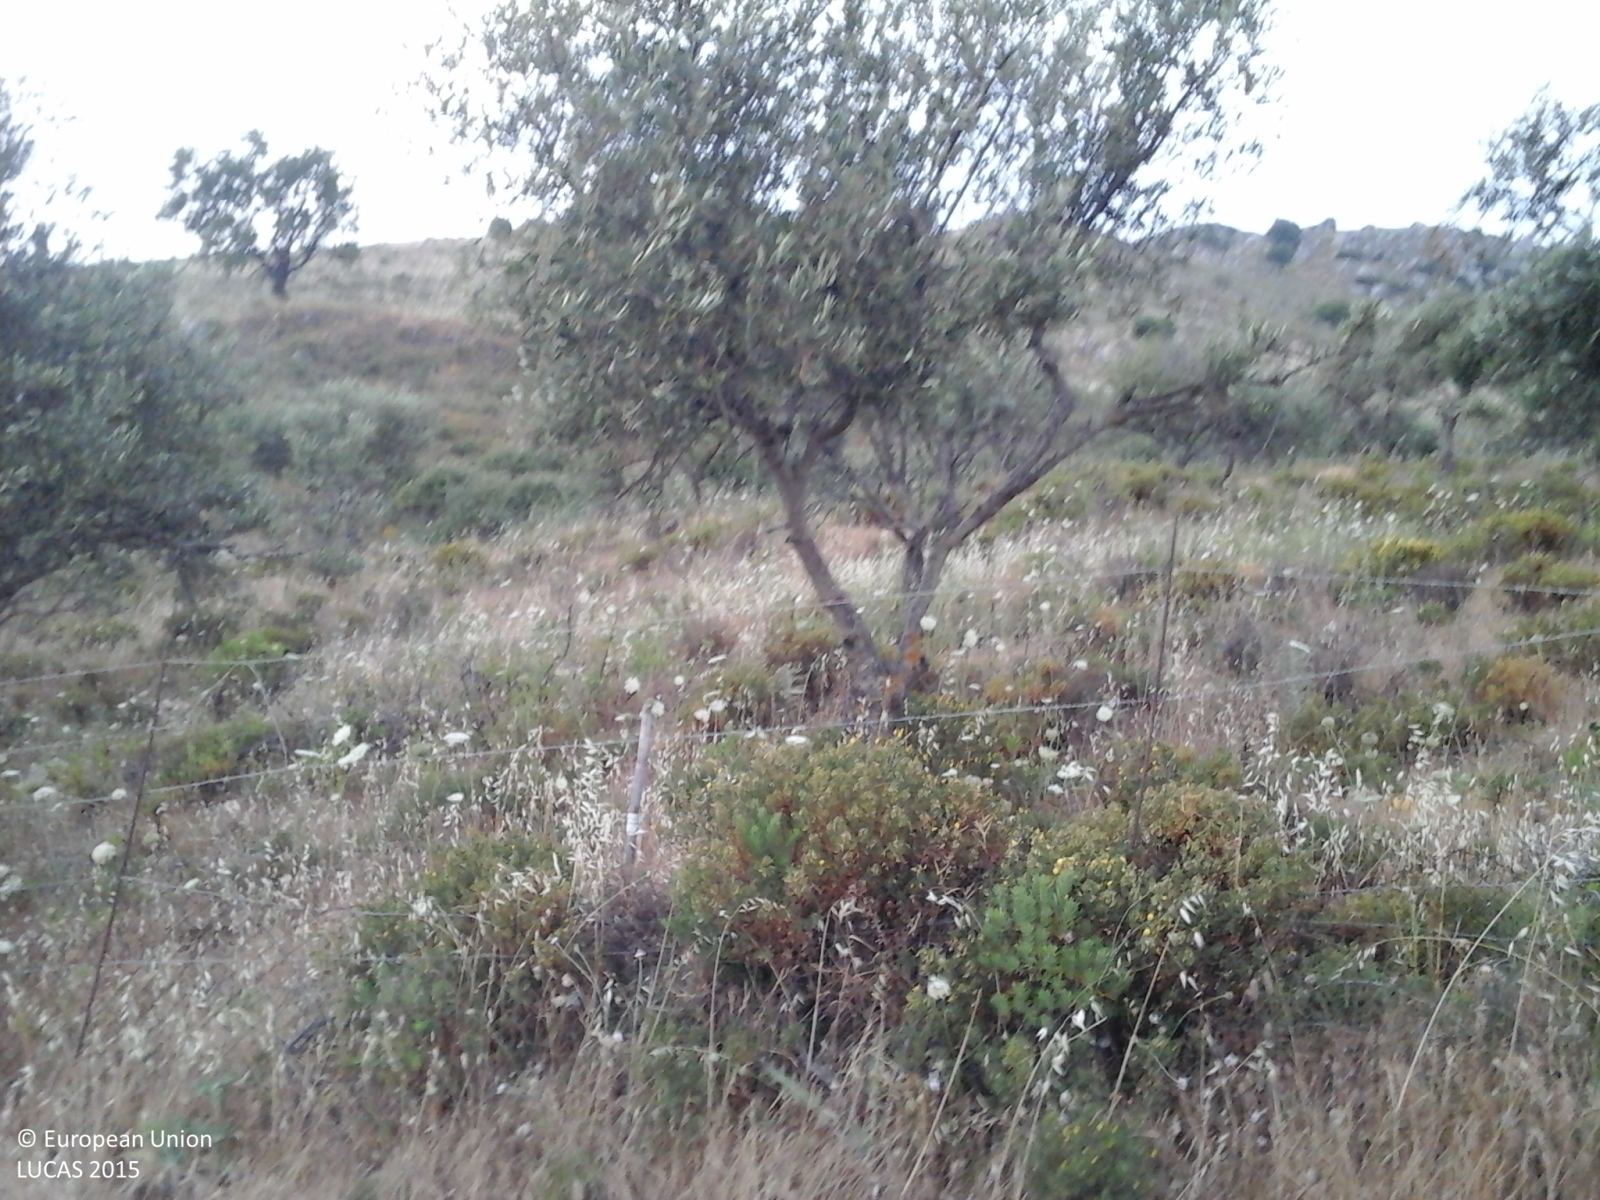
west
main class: Grassland
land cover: Grassland with sparse tree/shrub cover
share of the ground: > 75 %
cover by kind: herbaceous plants 85 %, shrubs 10 %, broadleaved forest trees 5 %
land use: Semi-natural and natural areas not in use
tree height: < 5 m
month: June
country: IT
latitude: 37.2736
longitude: 14.5778
